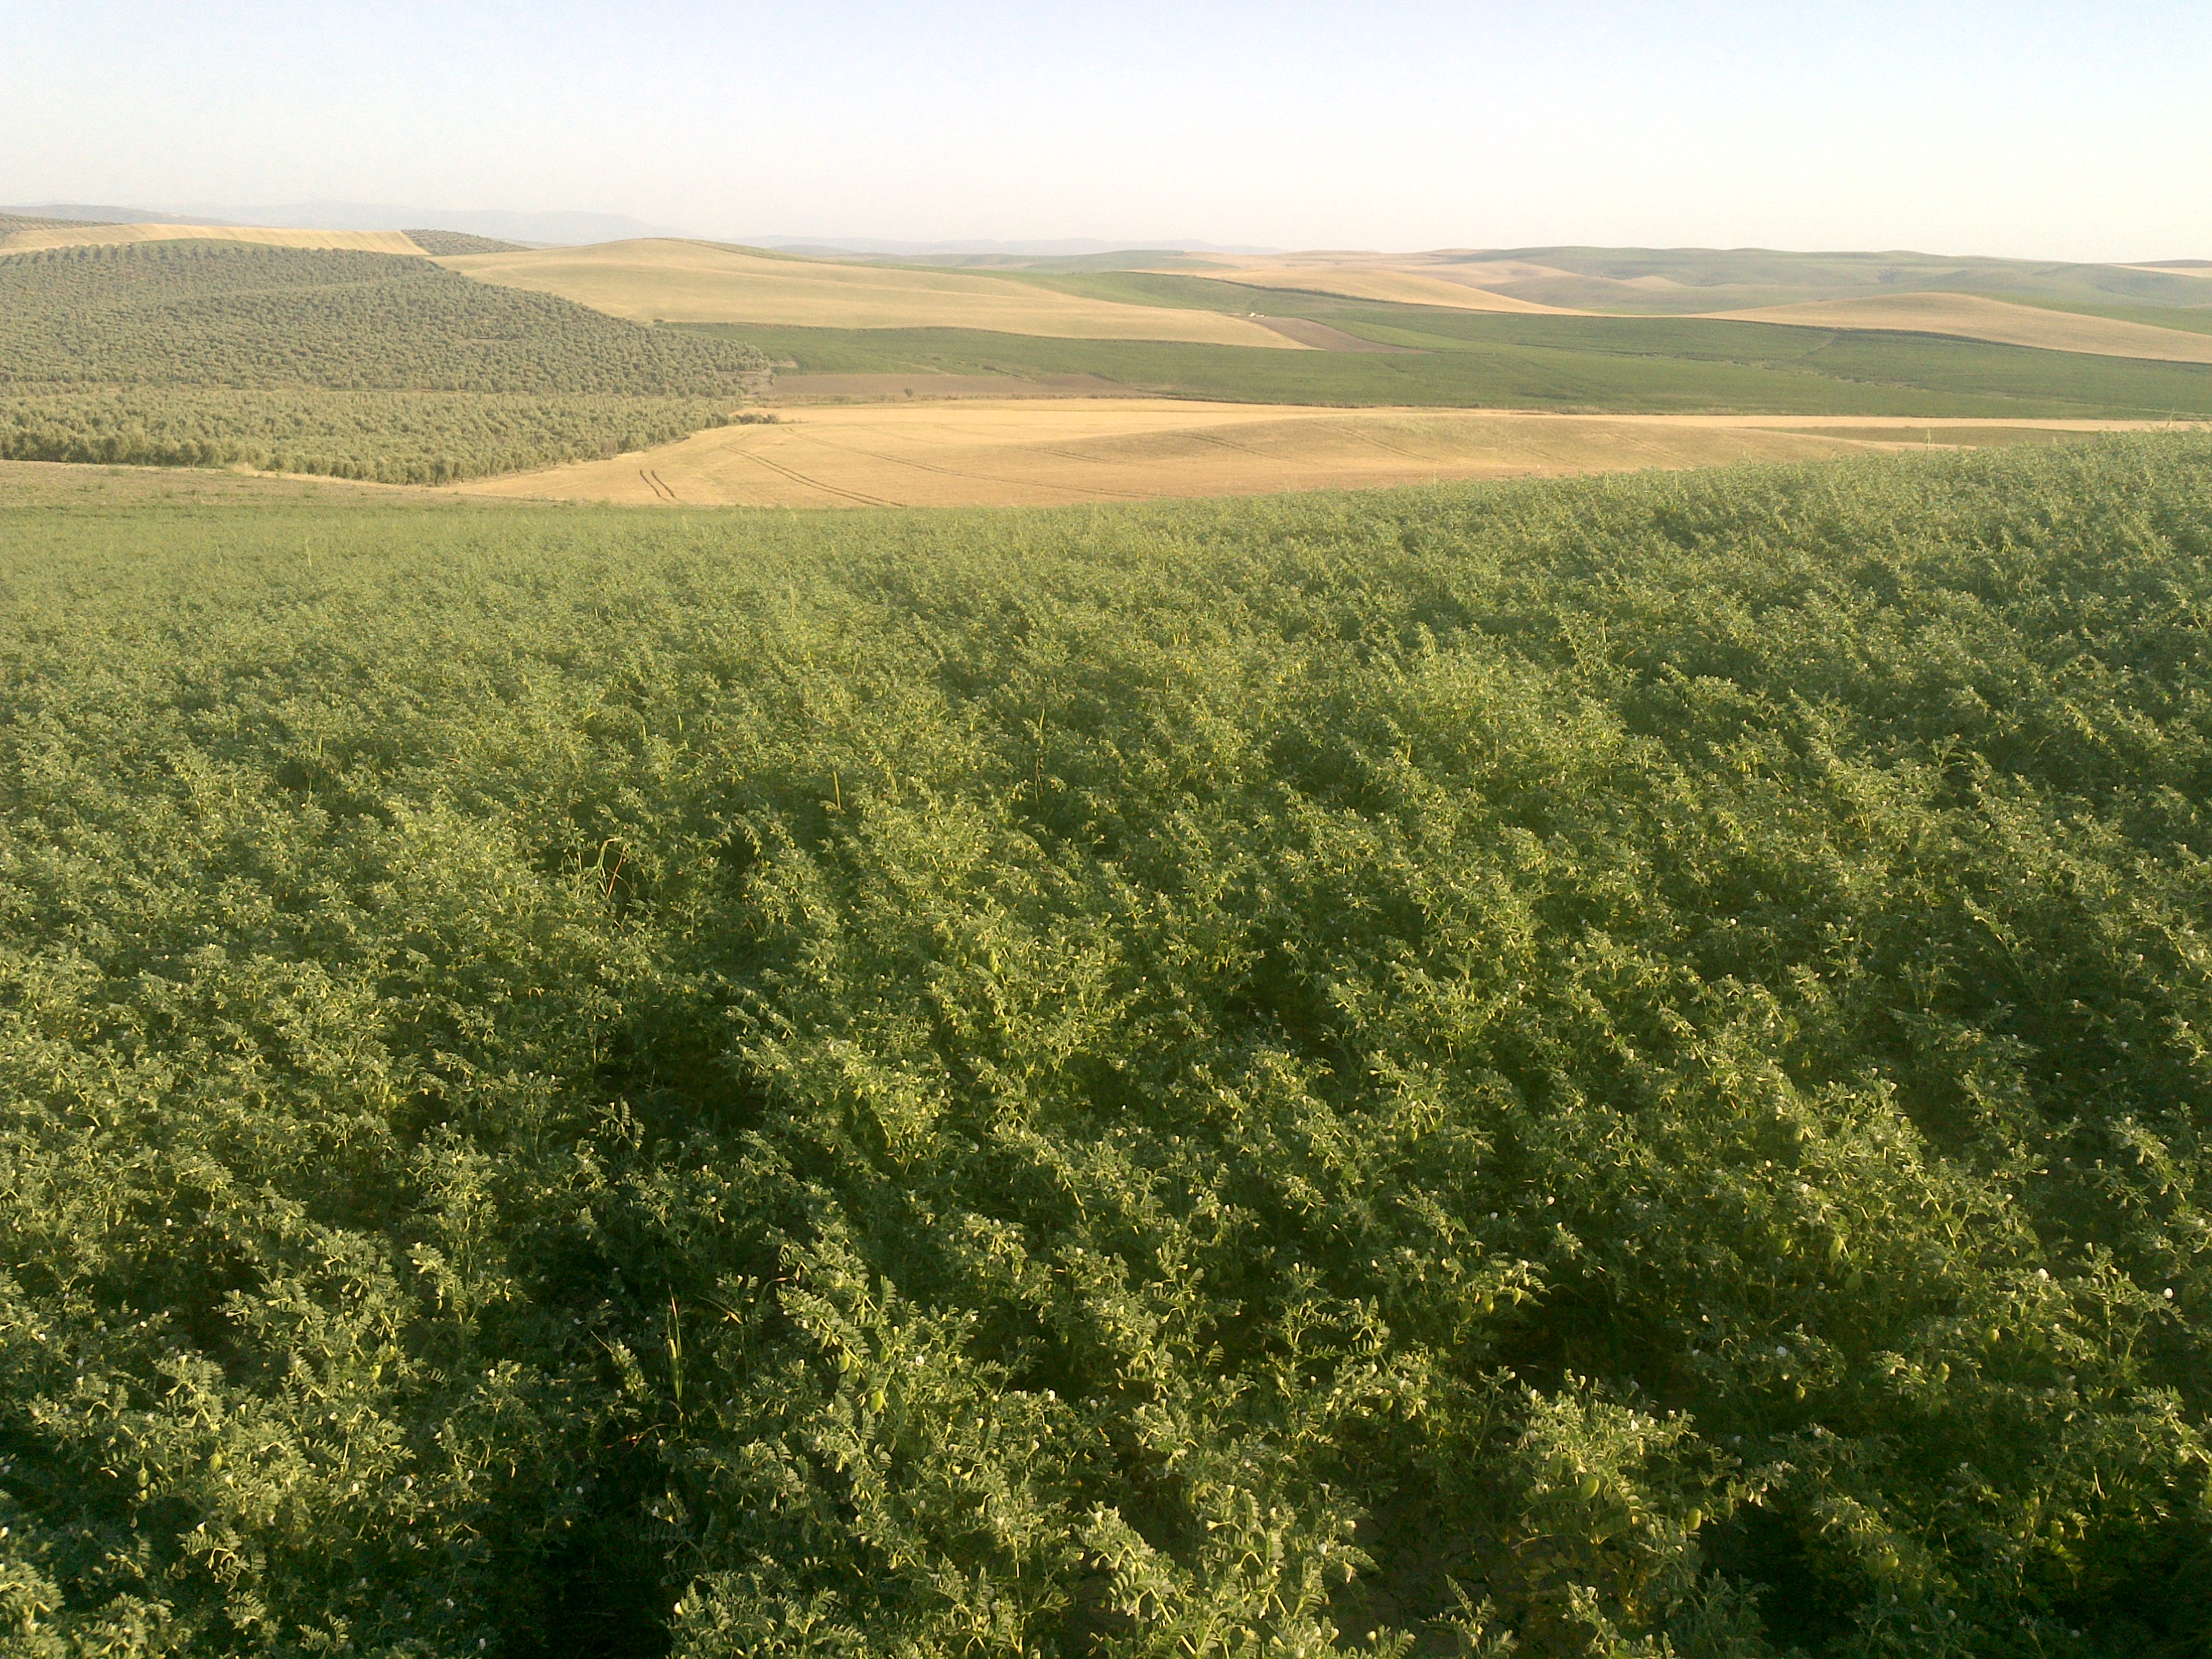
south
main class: Cropland
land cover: Dry pulses
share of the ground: > 75 %
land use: Agriculture (excluding fallow land and kitchen gardens)
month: May
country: ES
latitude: 37.8858
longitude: -4.4619
